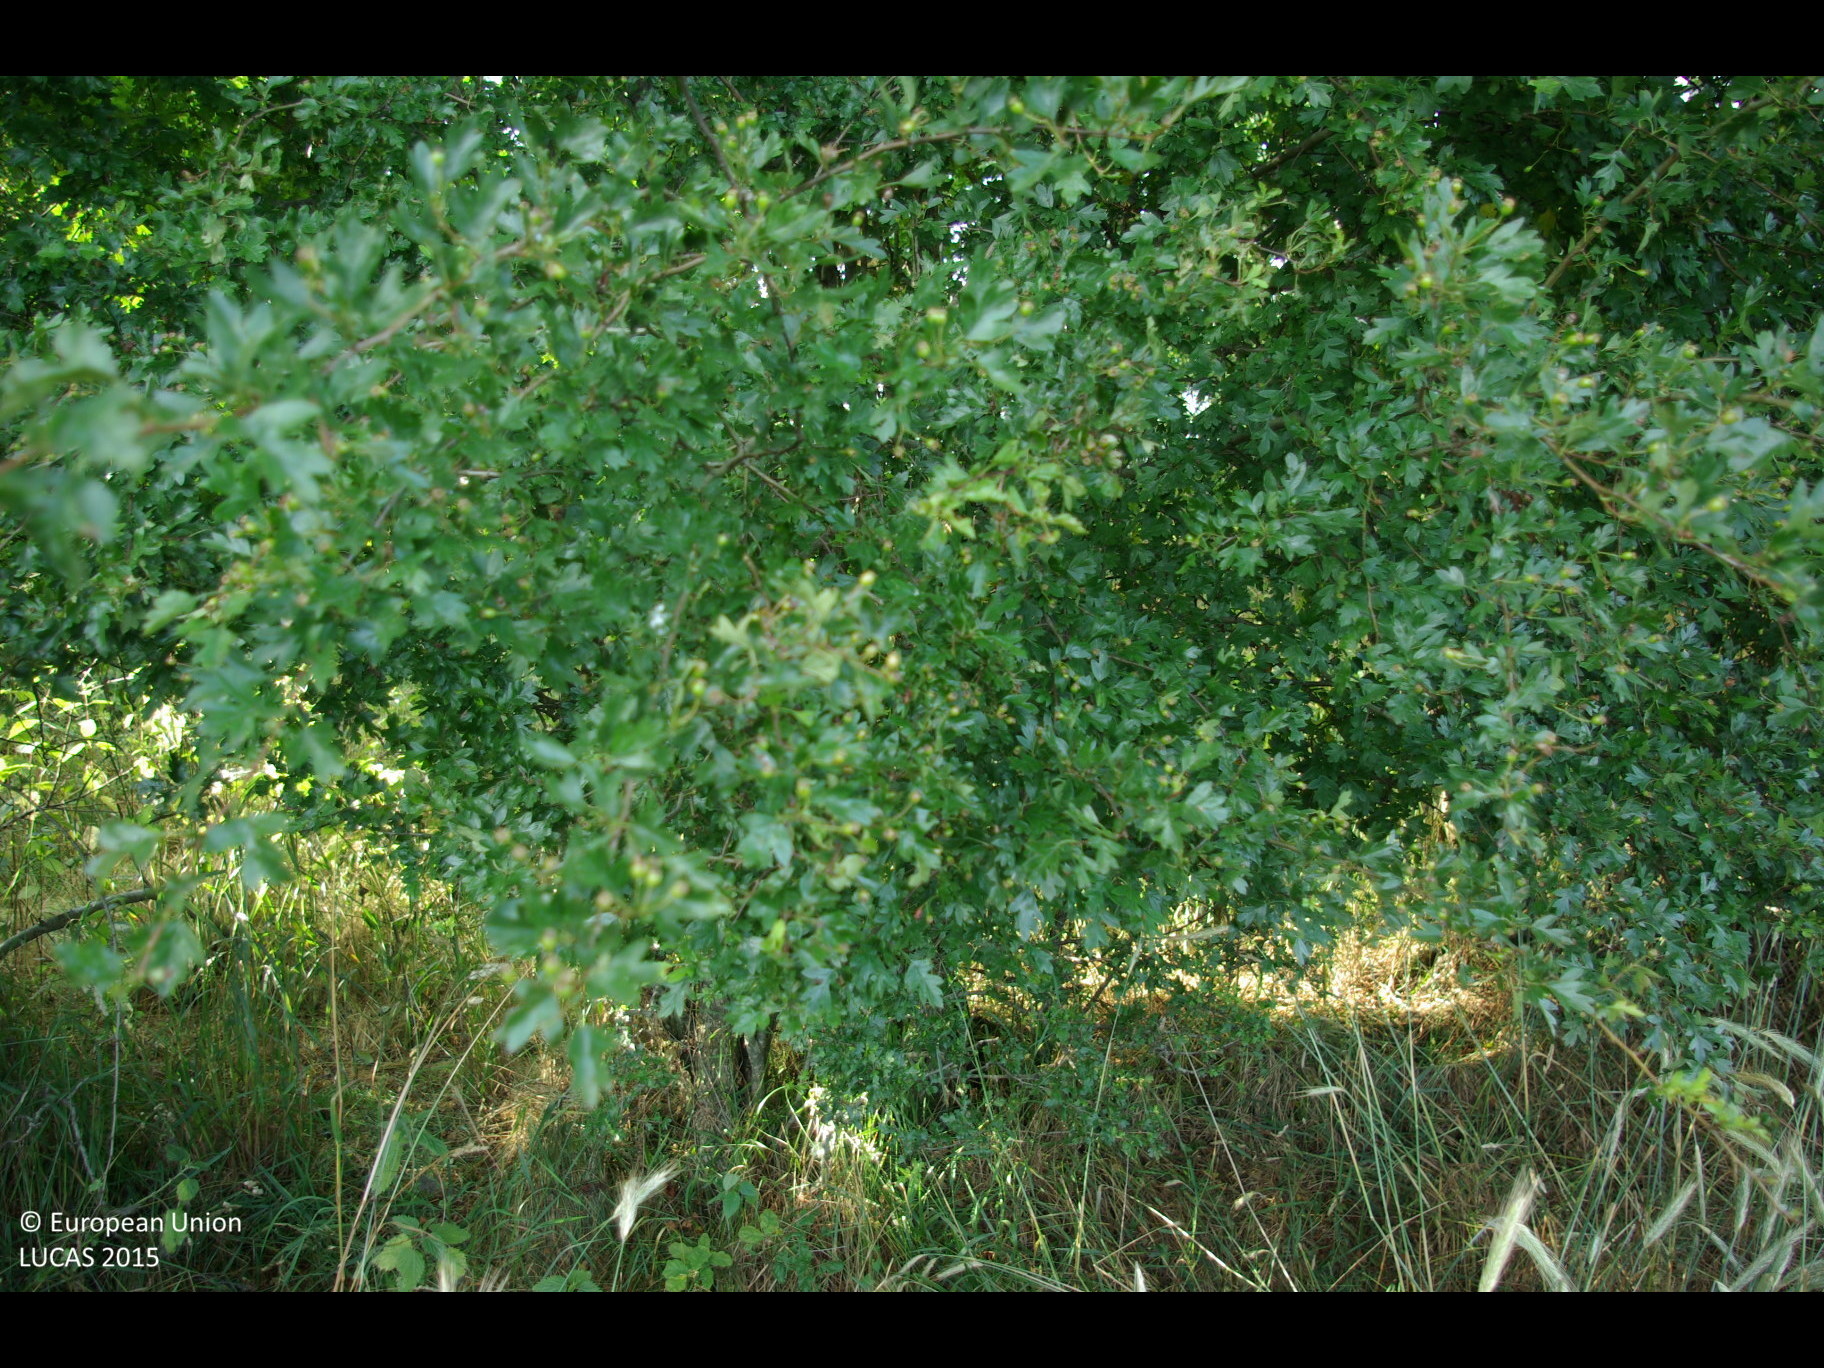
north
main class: Cropland
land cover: Rye
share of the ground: > 75 %
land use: Agriculture (excluding fallow land and kitchen gardens)
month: July
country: DE
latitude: 54.7836
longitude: 9.2697
